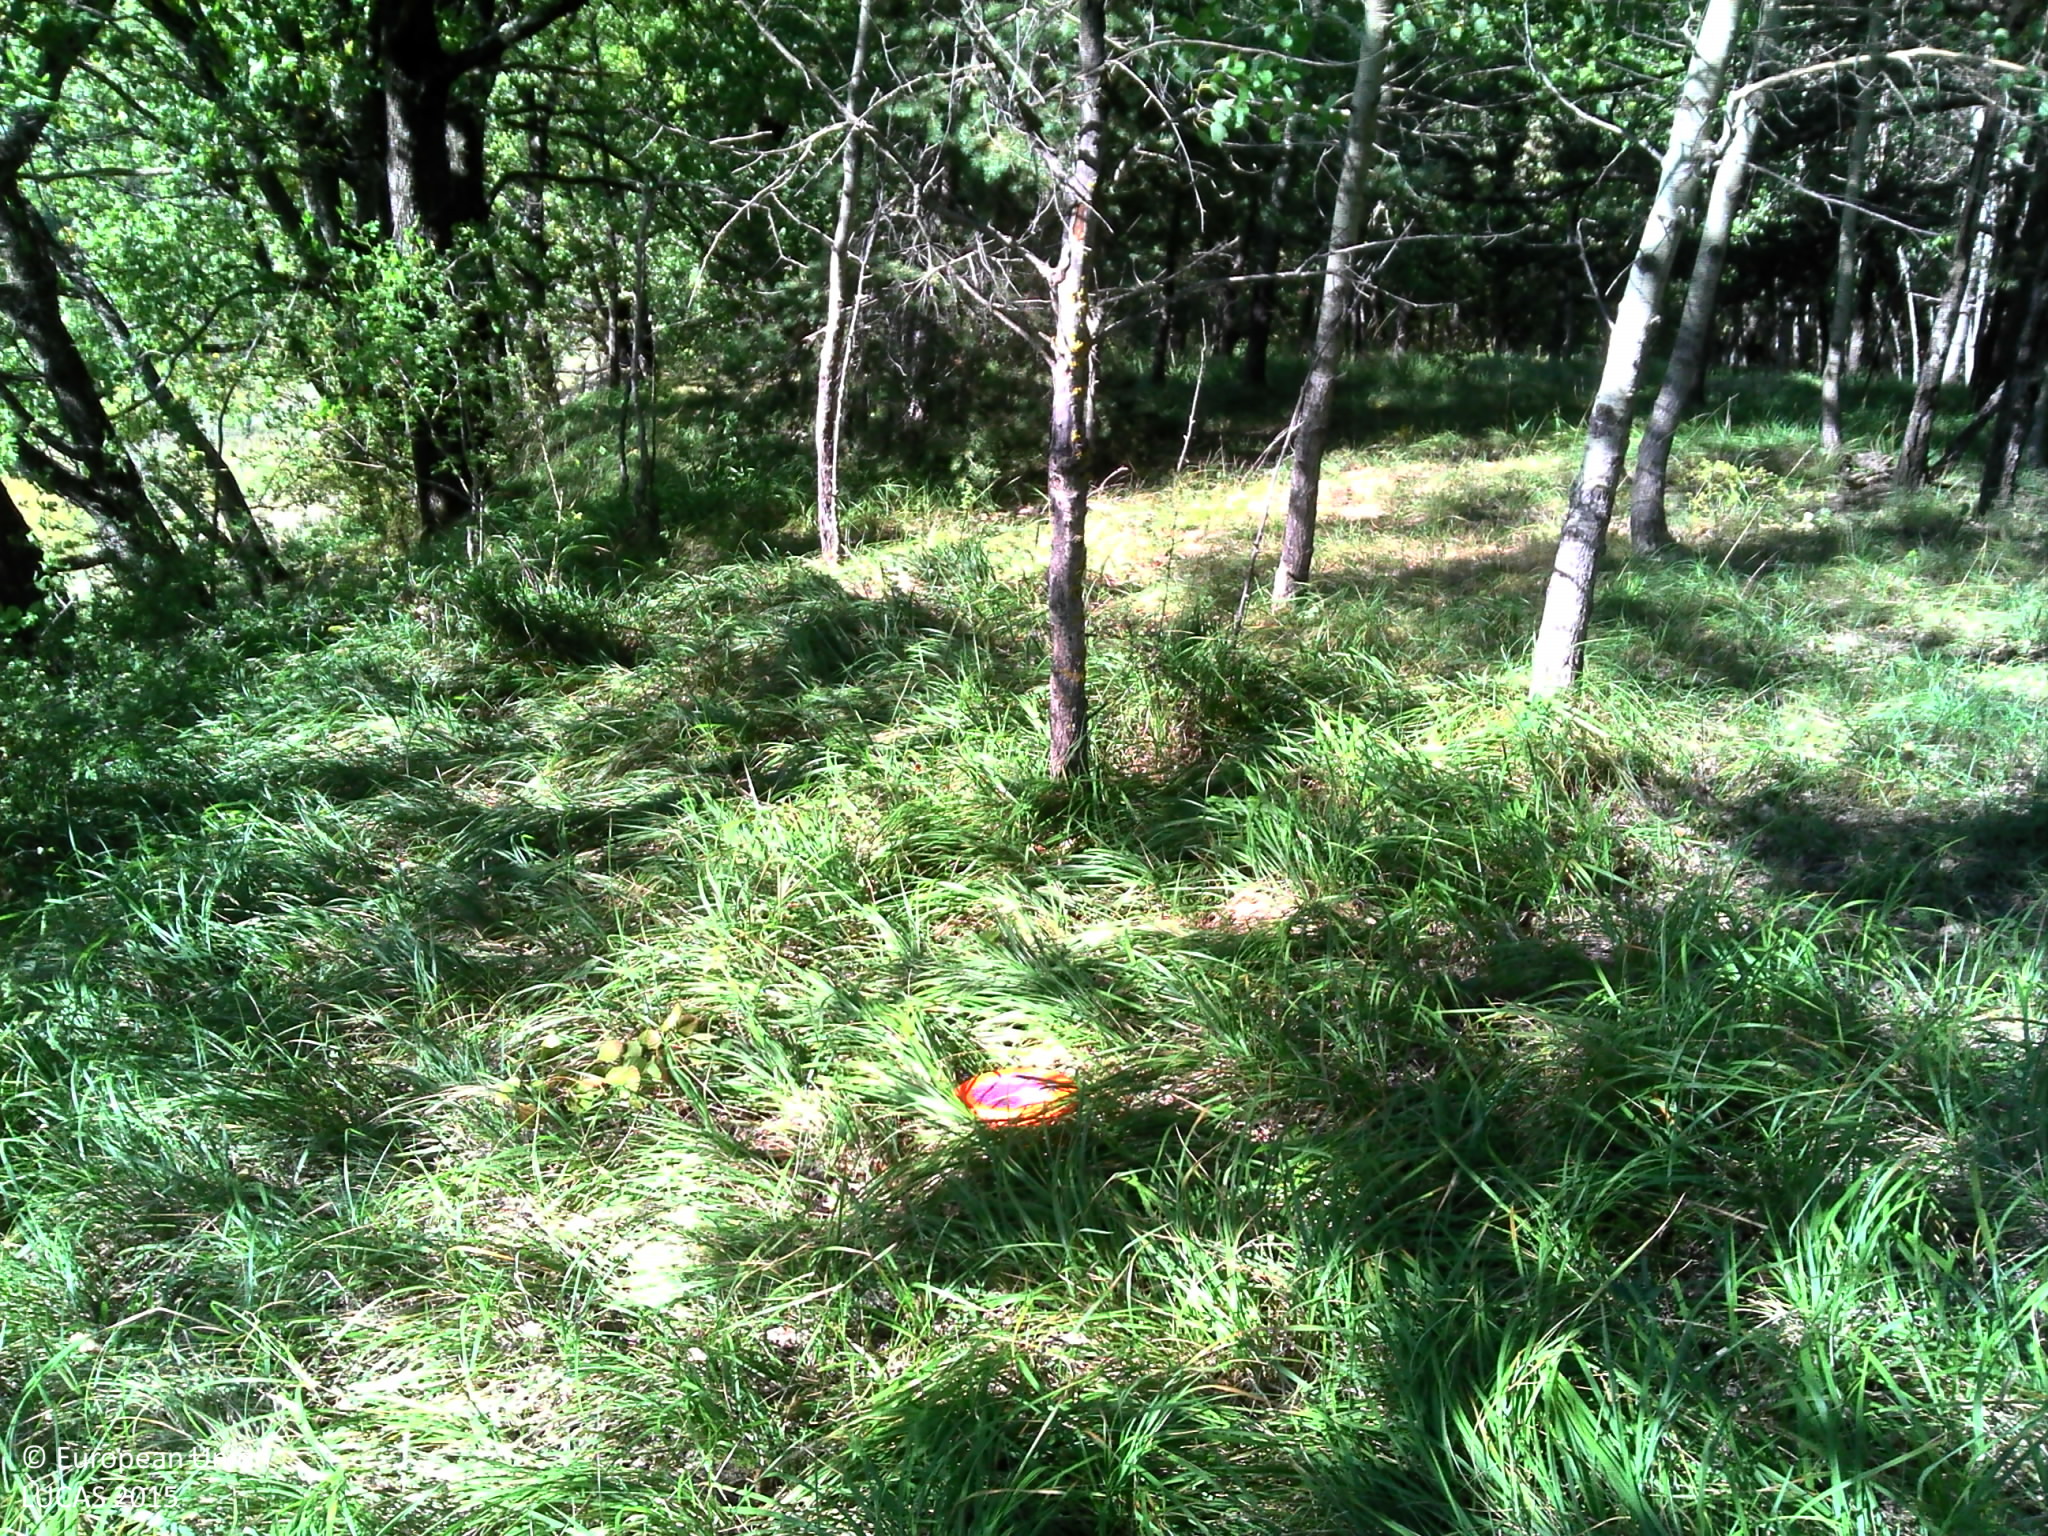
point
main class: Woodland
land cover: Broadleaved woodland
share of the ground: 25 - 50 %
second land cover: Grassland without tree/shrub cover
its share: > 75 %
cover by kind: broadleaved forest trees 70 %, herbaceous plants 25 %, coniferous forest trees 5 %
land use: Forestry
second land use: Agriculture (excluding fallow land and kitchen gardens)
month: October
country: FR
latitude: 44.5542
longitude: 6.2677
